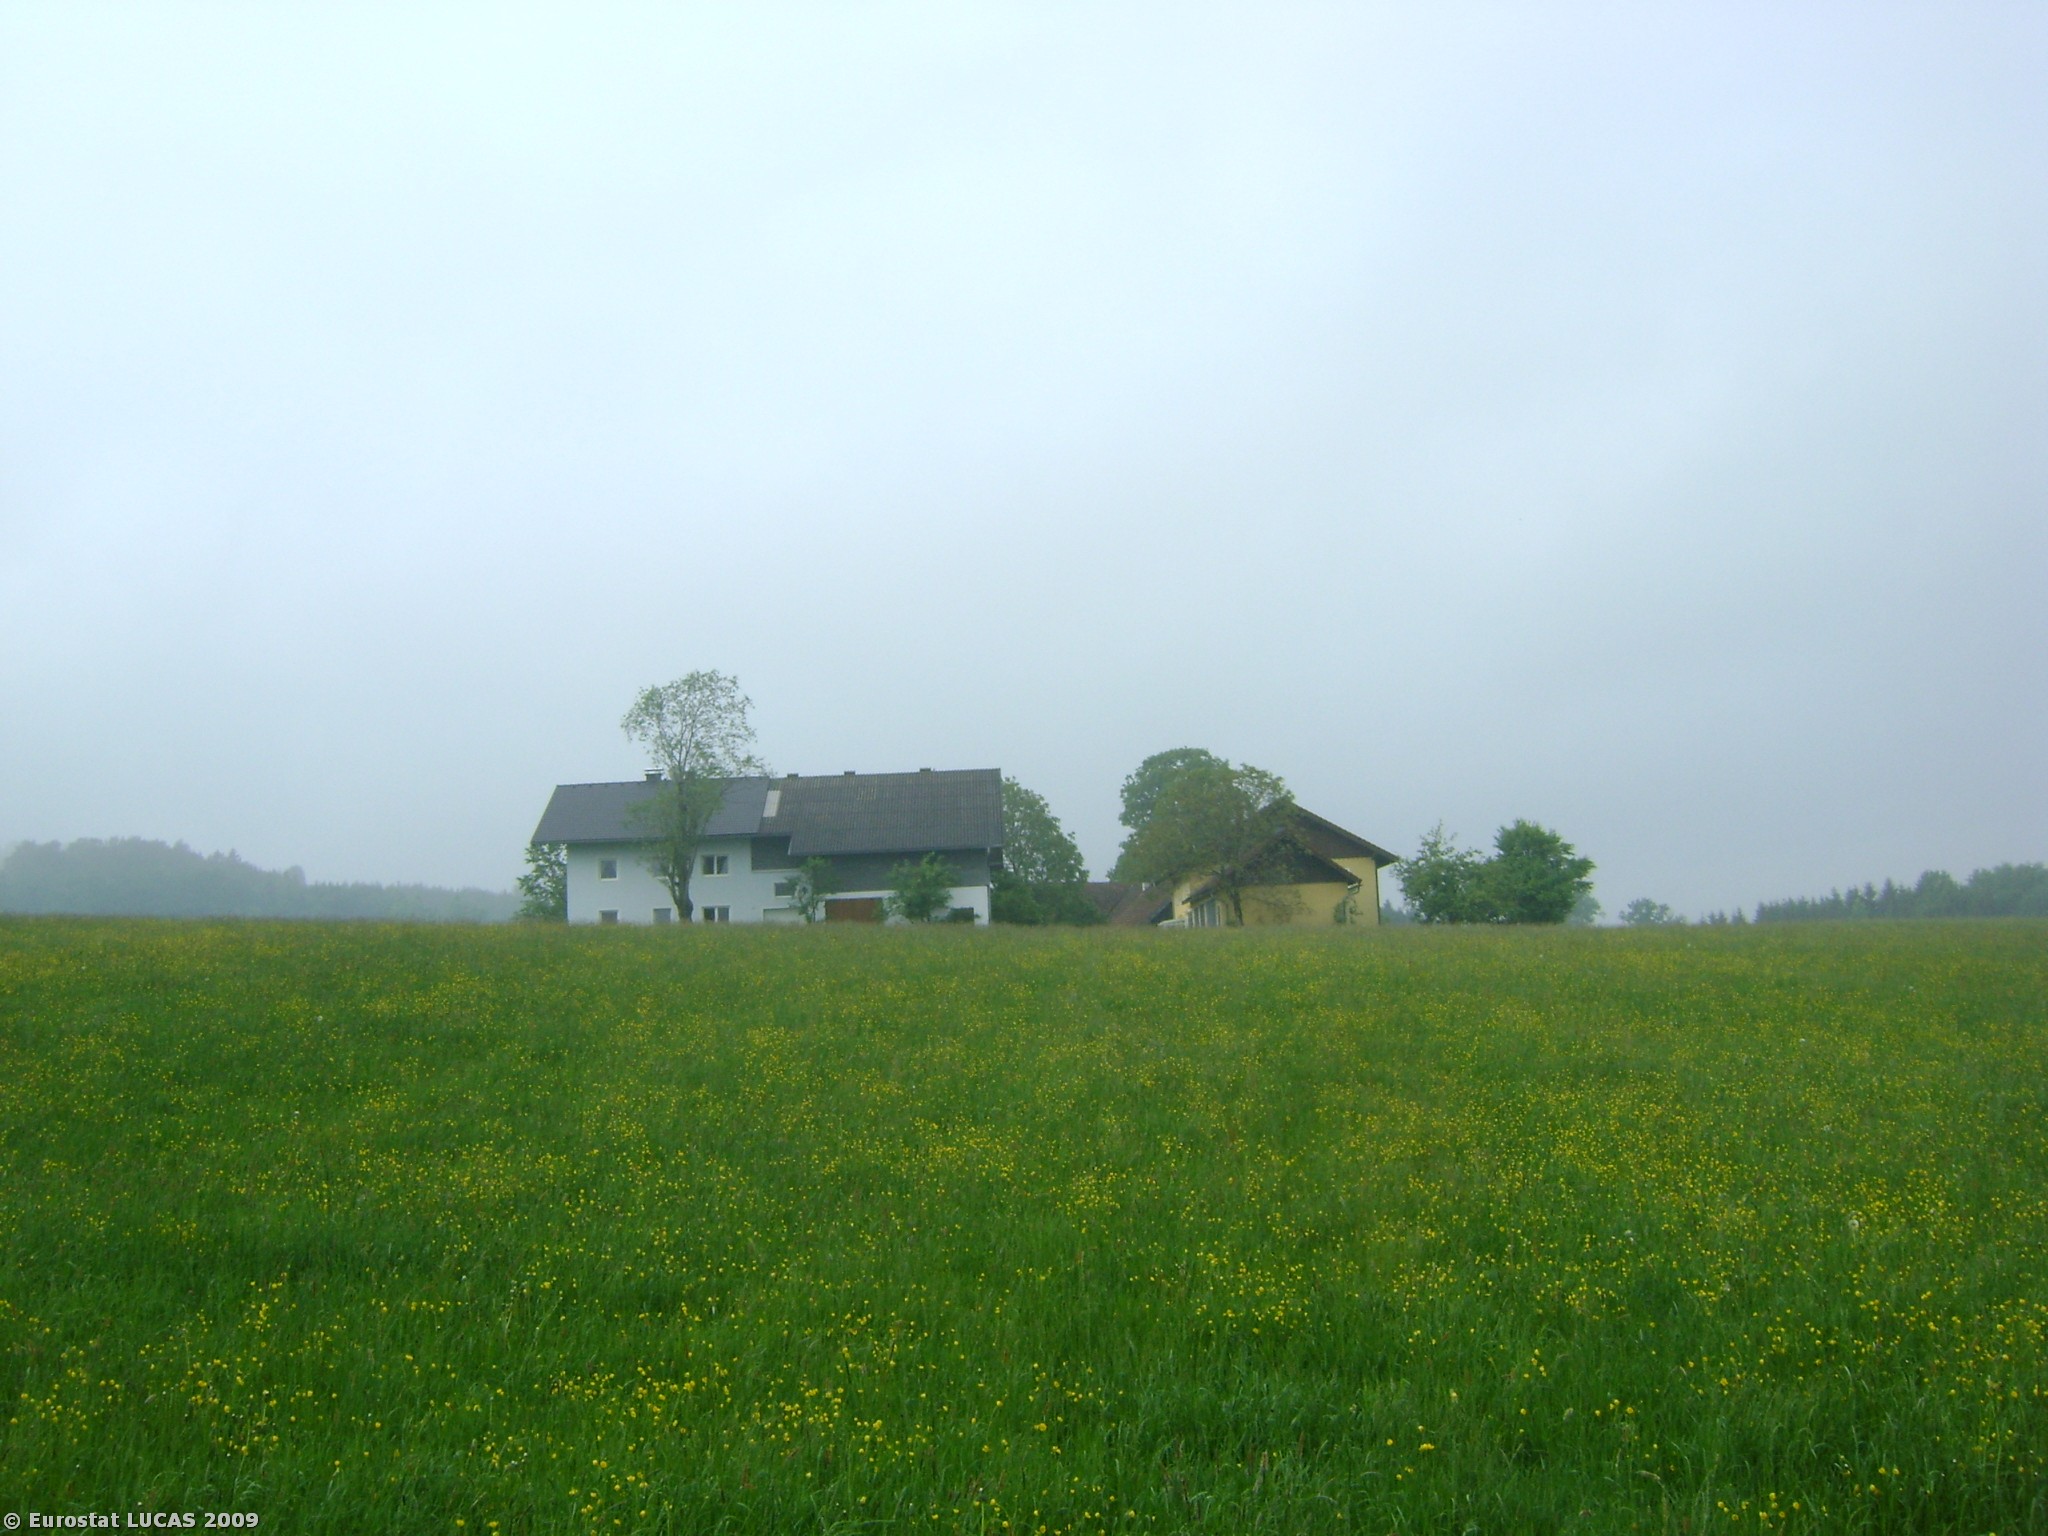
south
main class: Grassland
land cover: Grassland without tree/shrub cover
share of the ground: > 75 %
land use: Agriculture (excluding fallow land and kitchen gardens)
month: May
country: AT
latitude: 47.9594
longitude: 13.2531
